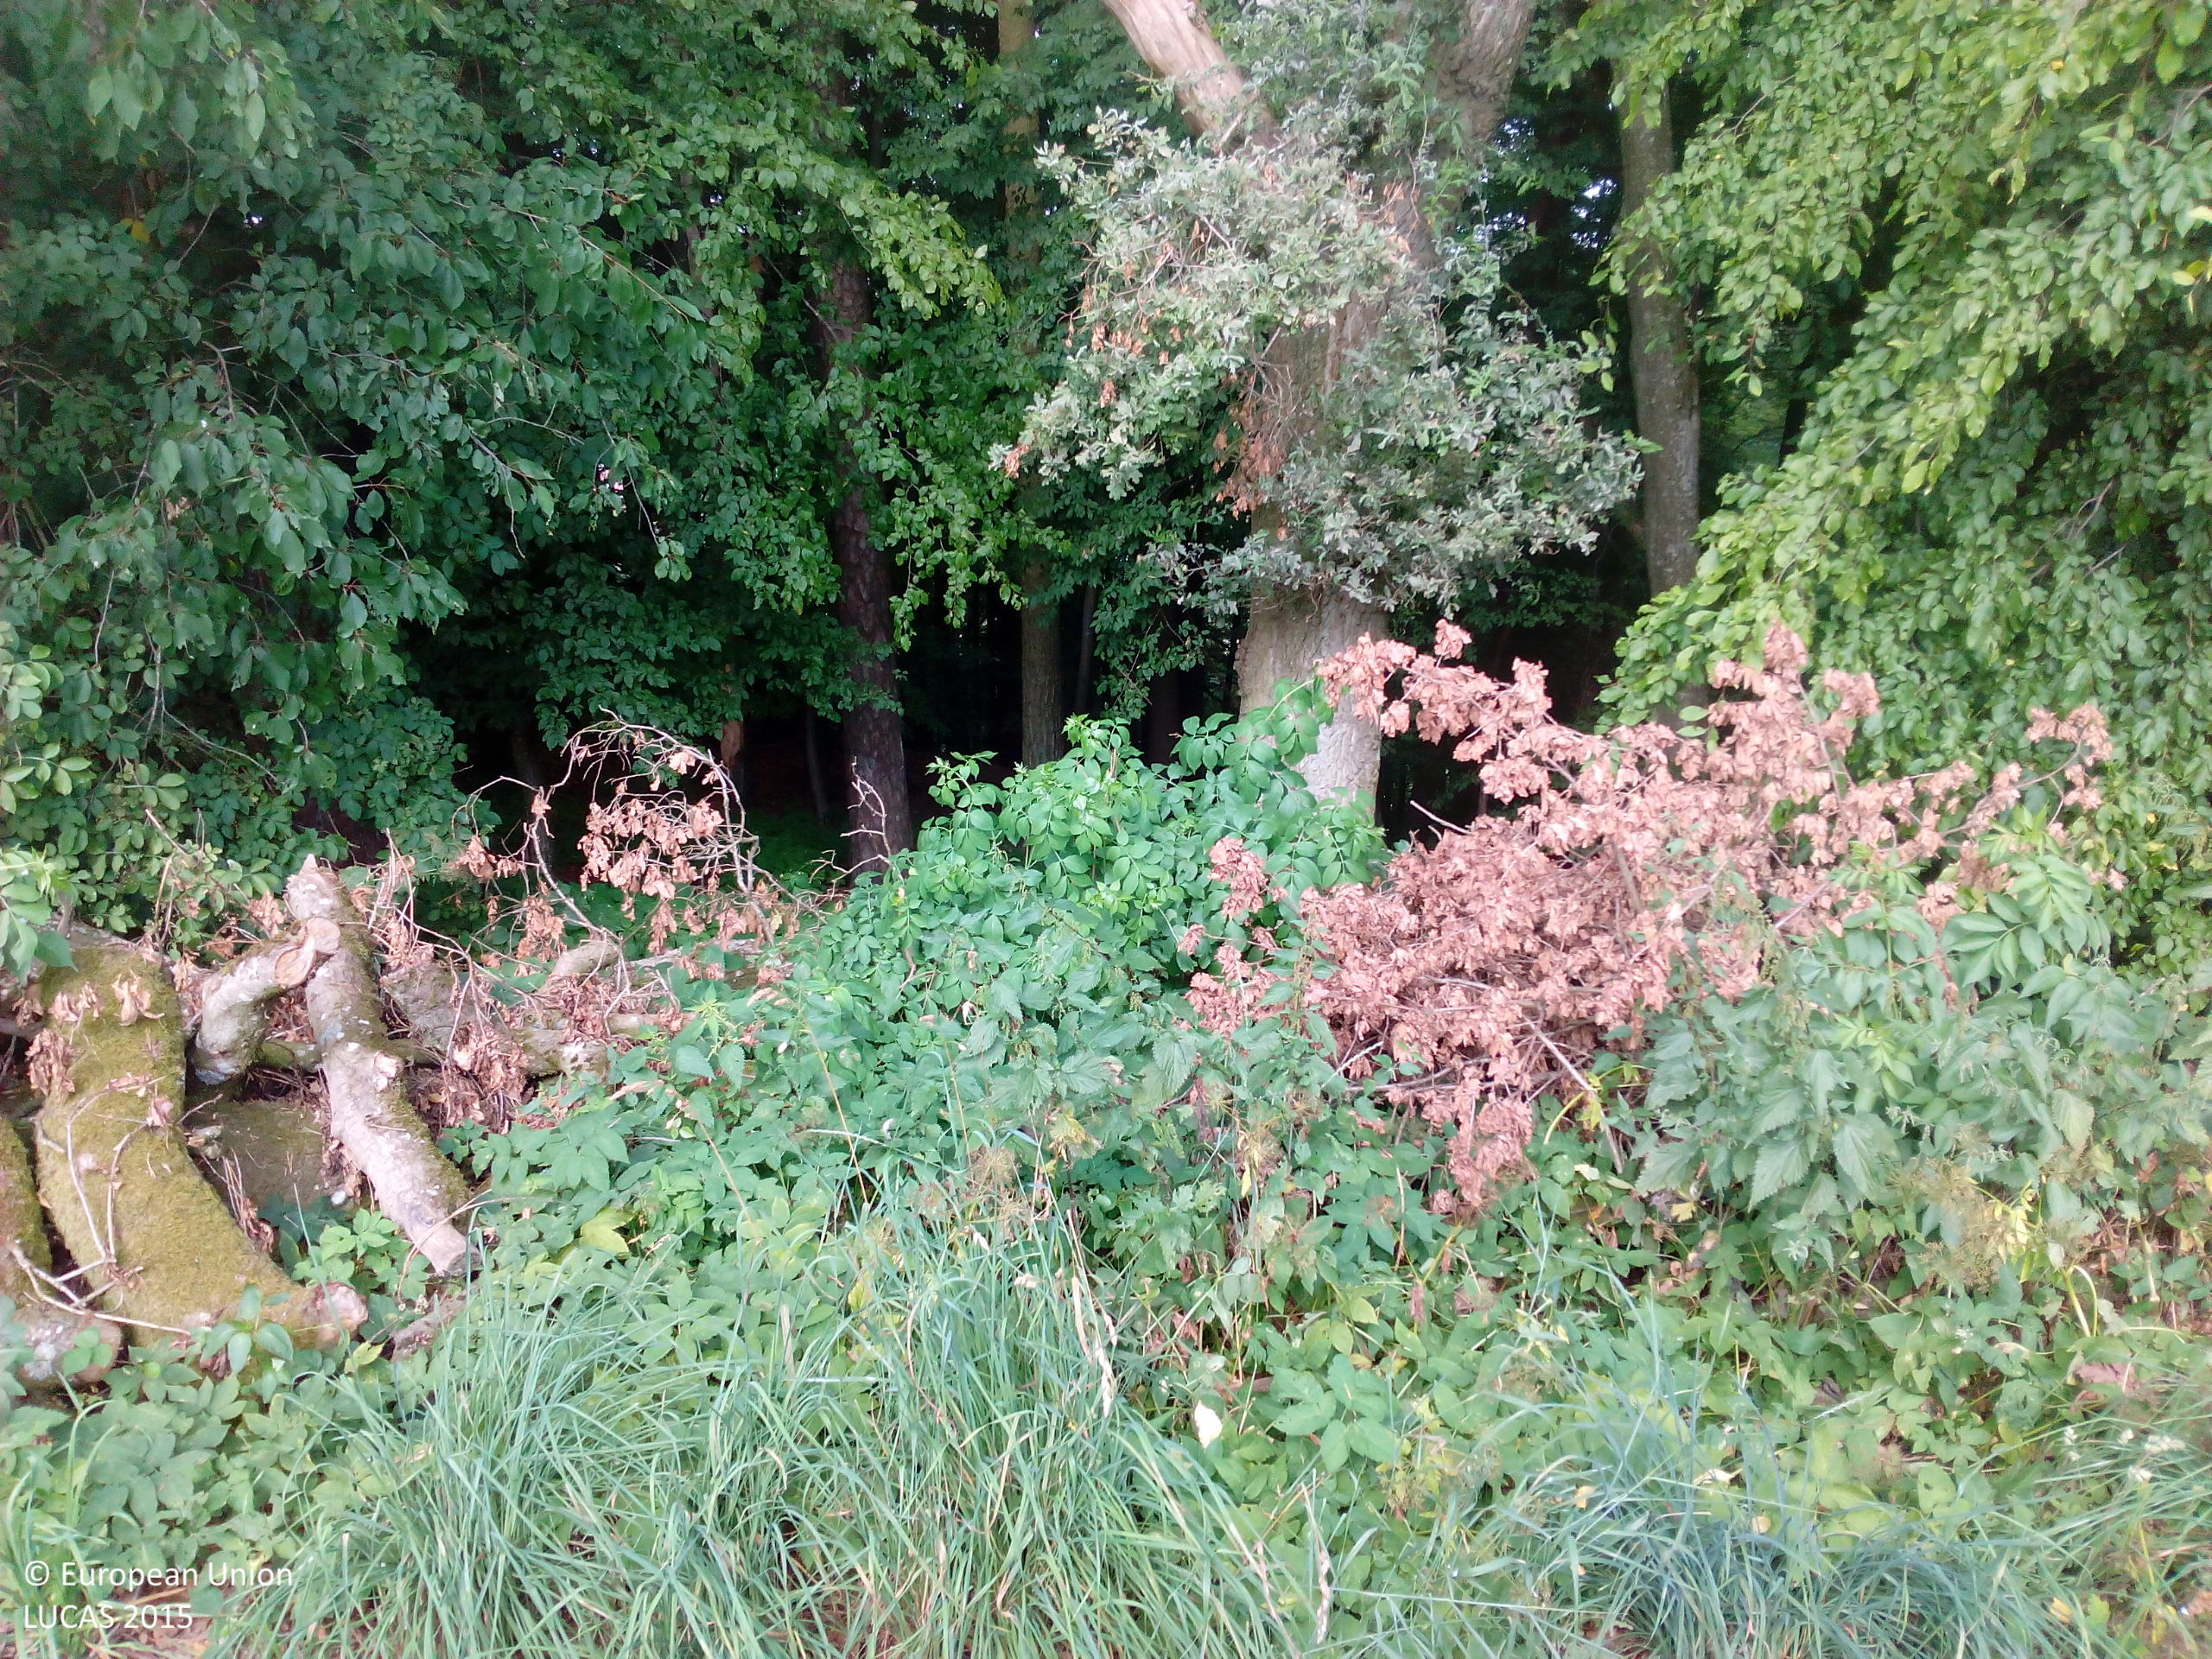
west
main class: Cropland
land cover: Maize
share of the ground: > 75 %
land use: Agriculture (excluding fallow land and kitchen gardens)
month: July
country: DE
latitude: 48.3115
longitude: 12.8981
